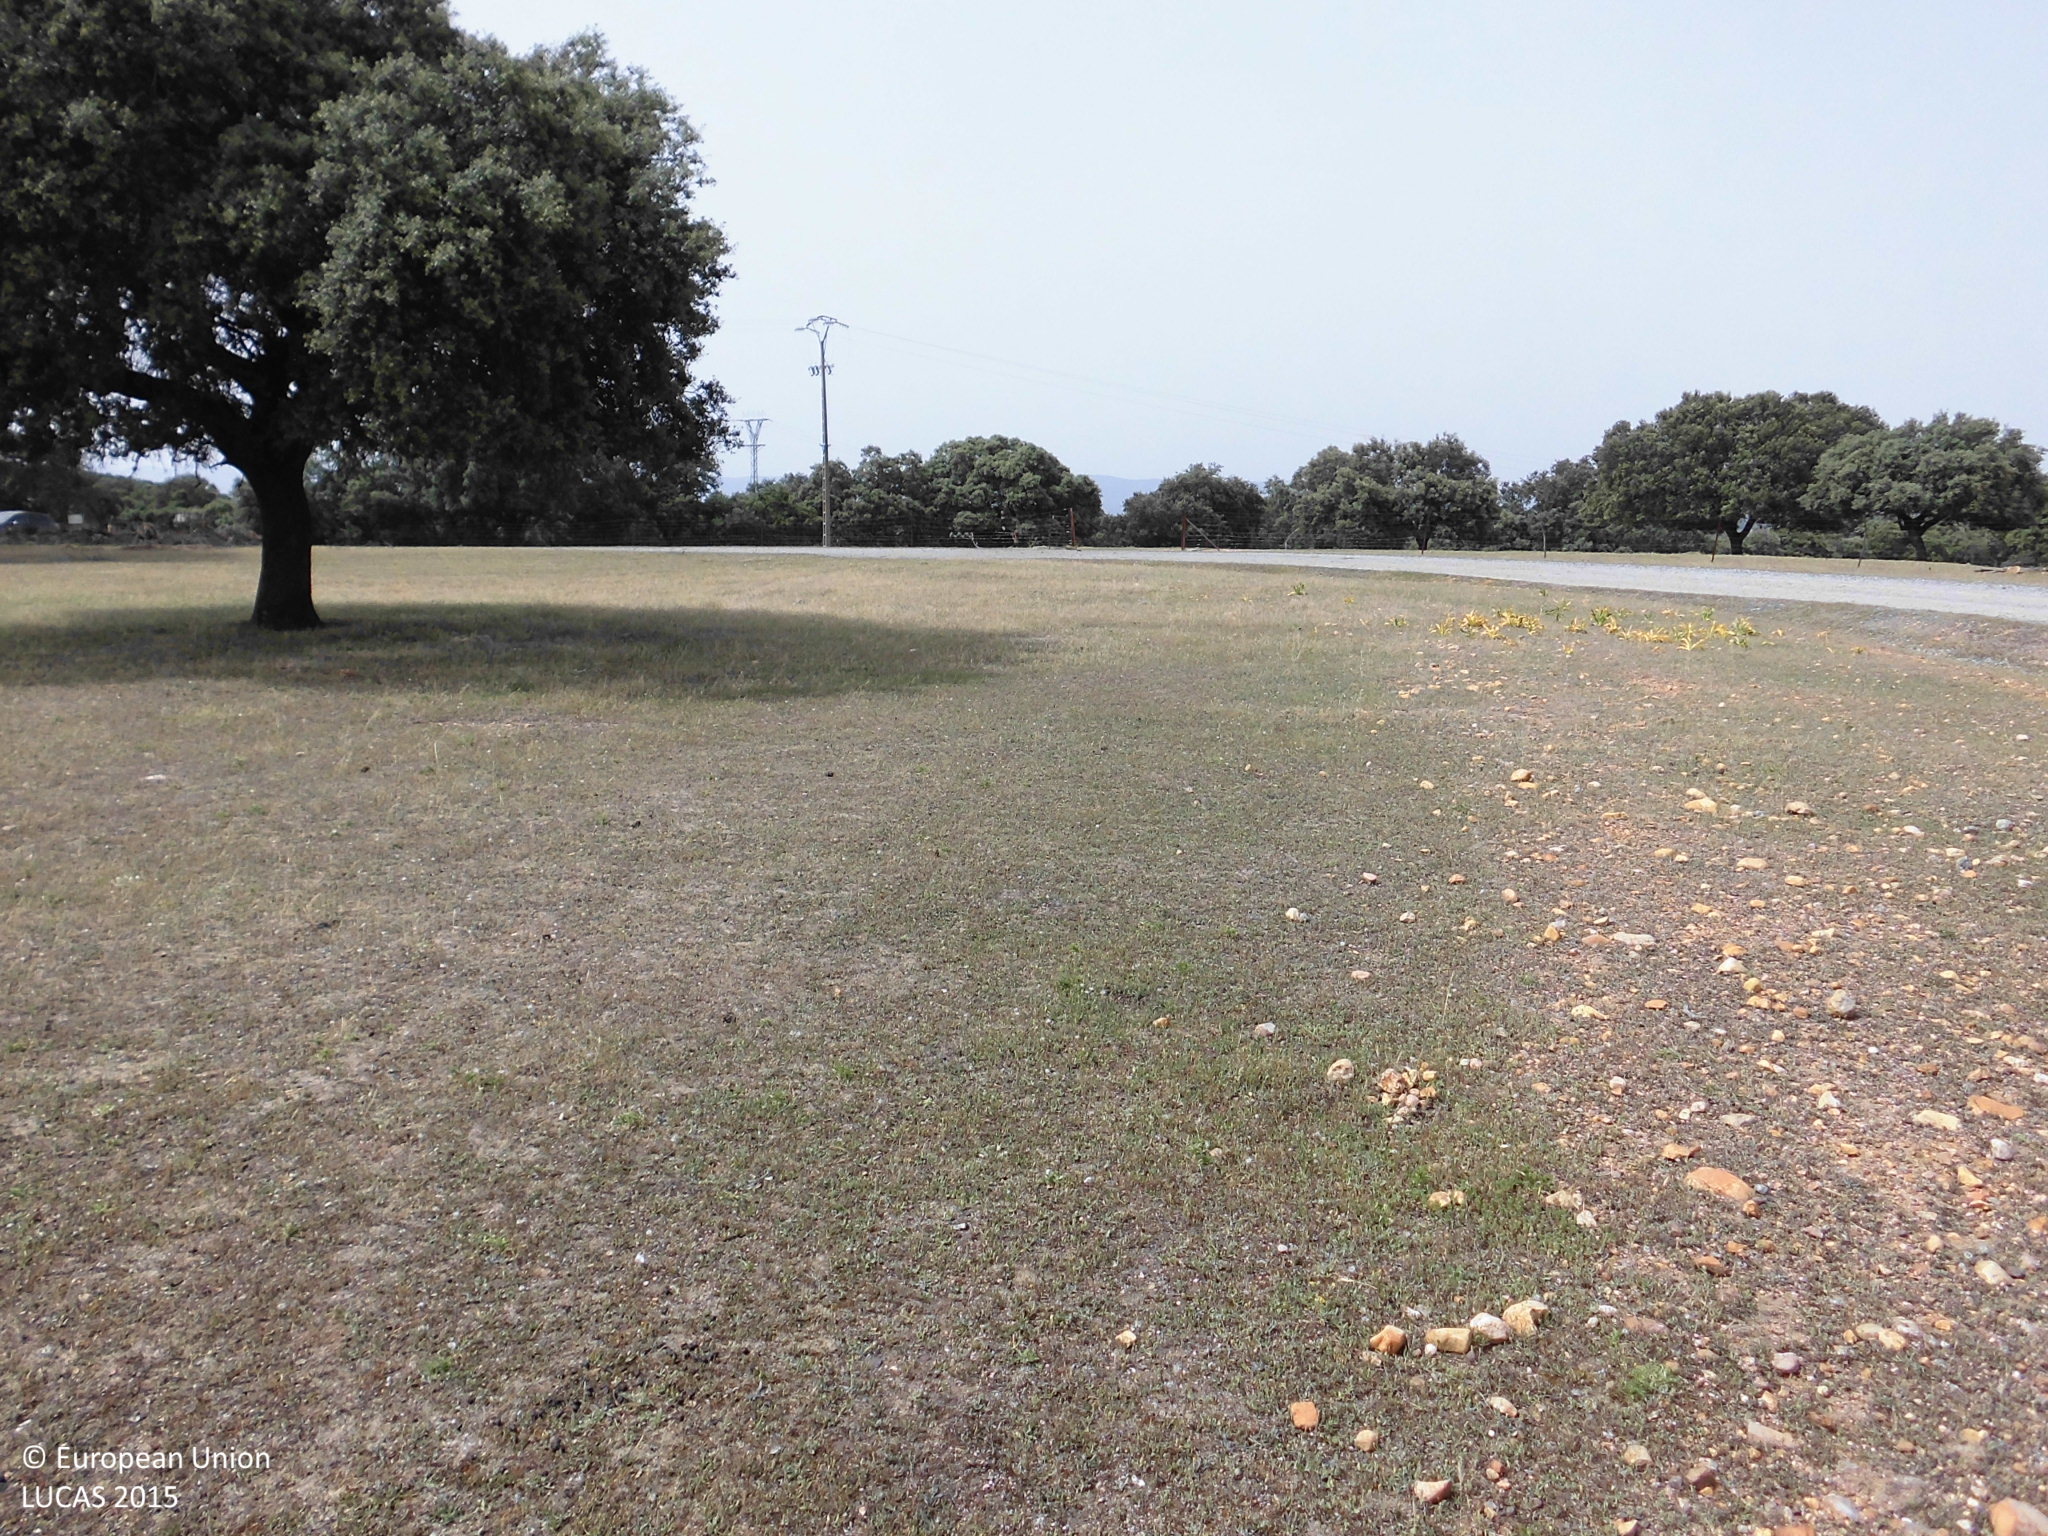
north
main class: Grassland
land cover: Grassland with sparse tree/shrub cover
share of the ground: > 75 %
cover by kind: herbaceous plants 65 %, consolidated bare surface 30 %, broadleaved forest trees 5 %
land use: Agriculture (excluding fallow land and kitchen gardens)
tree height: > 5 m
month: May
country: ES
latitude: 39.6928
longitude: -6.1480
